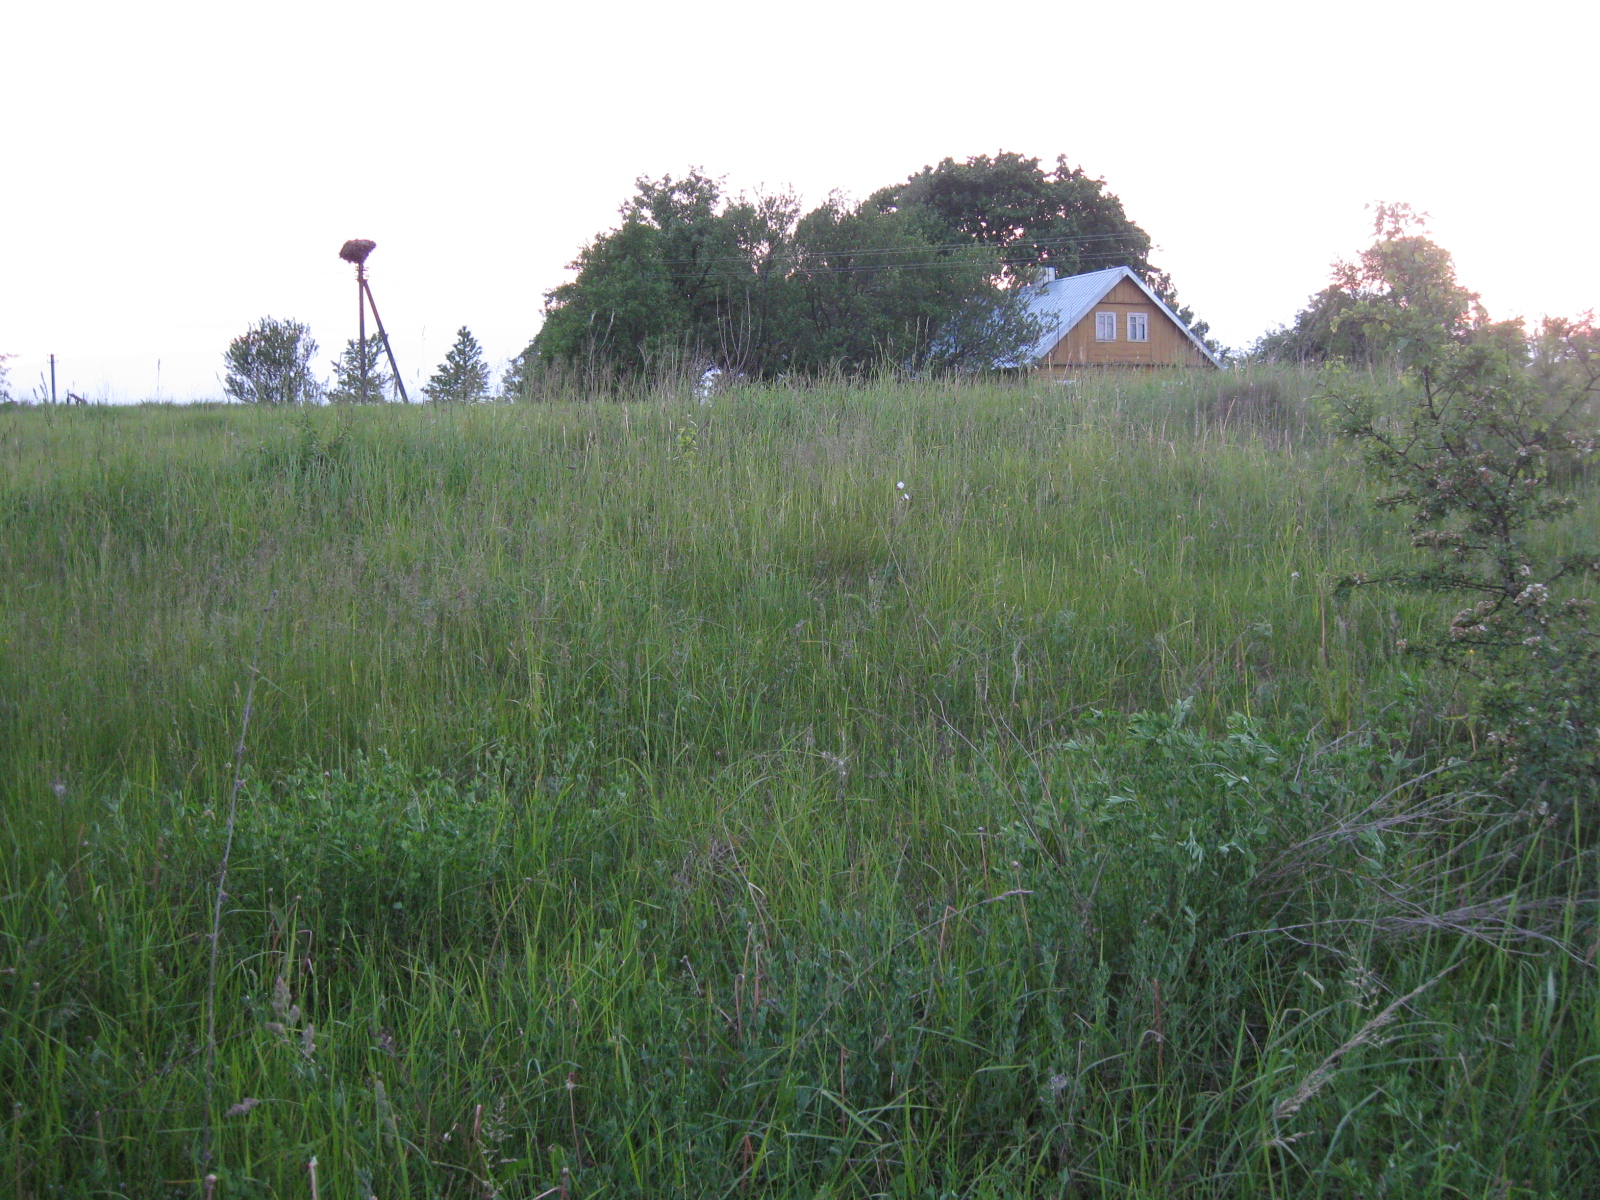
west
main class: Woodland
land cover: Pine dominated coniferous woodland
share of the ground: 25 - 50 %
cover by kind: herbaceous plants 65 %, coniferous forest trees 30 %, broadleaved forest trees 5 %
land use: Agriculture (excluding fallow land and kitchen gardens)
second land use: Forestry
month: June
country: LT
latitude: 54.1978
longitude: 23.7764
